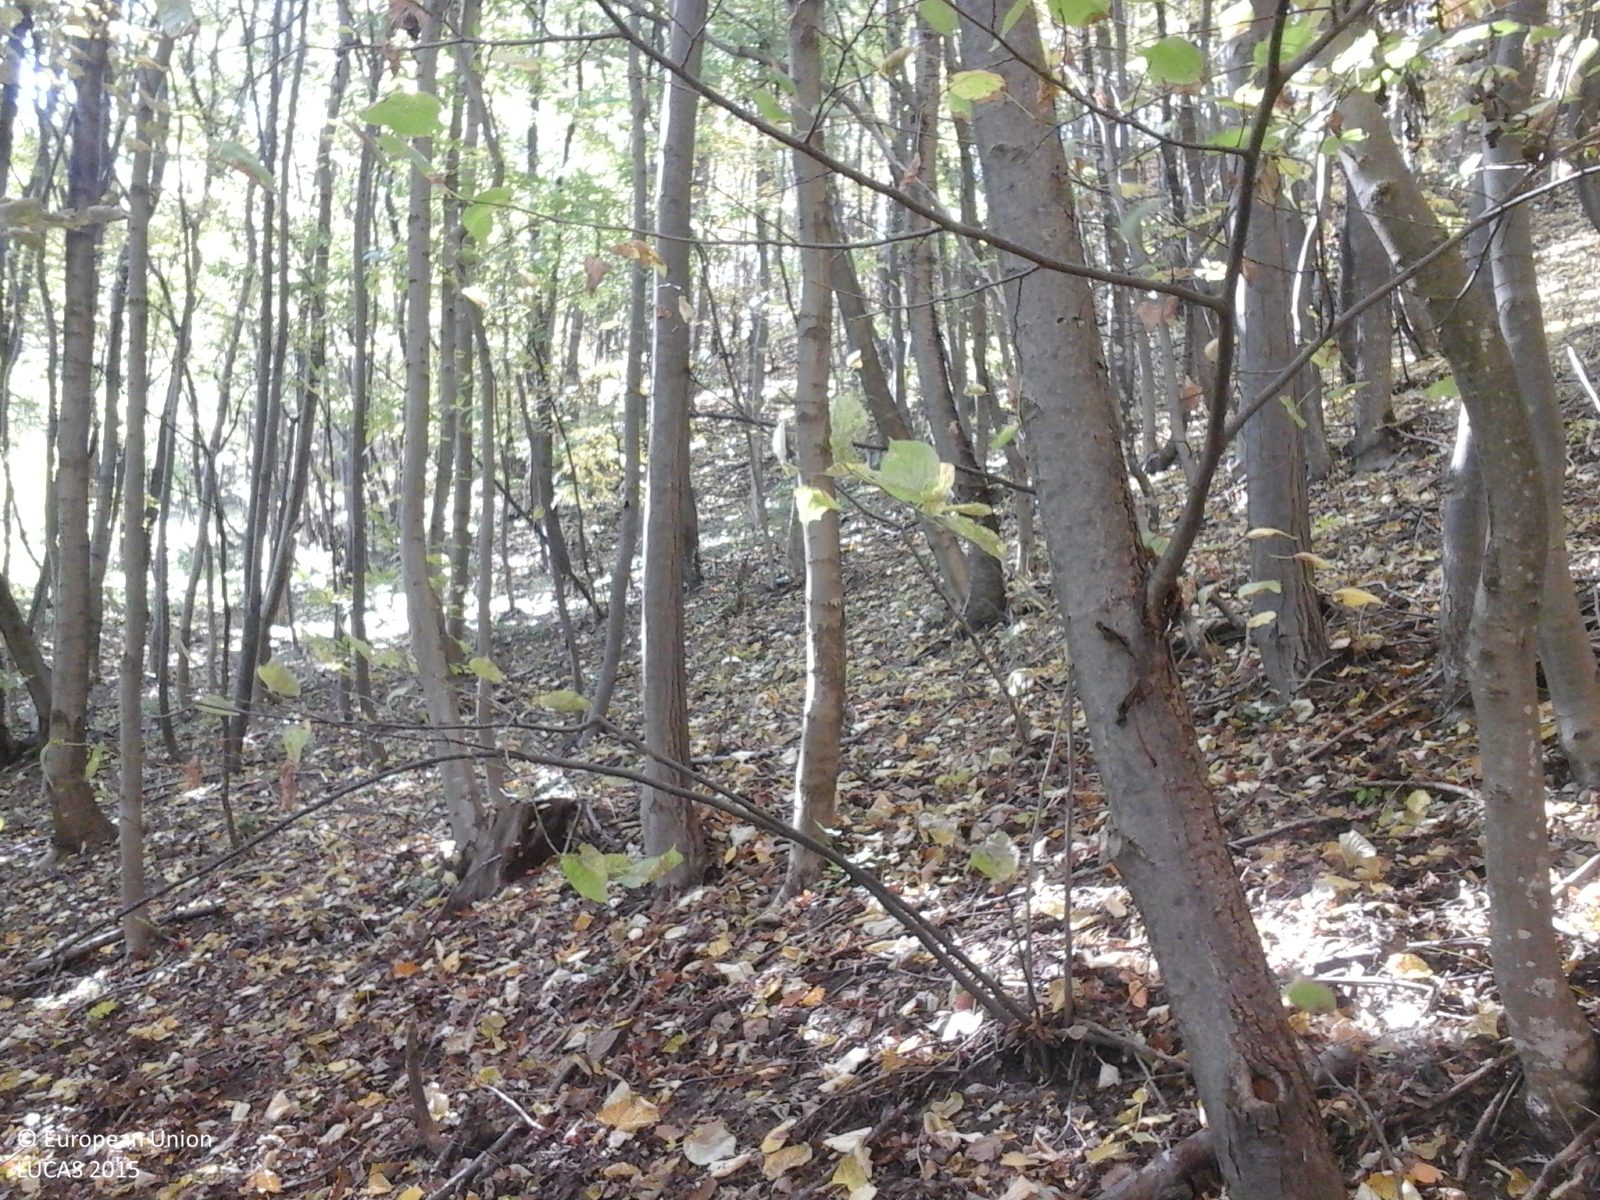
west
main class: Woodland
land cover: Broadleaved woodland
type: non-riverine alder, birch or aspen forest
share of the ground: > 75 %
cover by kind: broadleaved forest trees 100 %
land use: Forestry
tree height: > 5 m
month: October
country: RO
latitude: 45.4980
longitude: 26.6243
